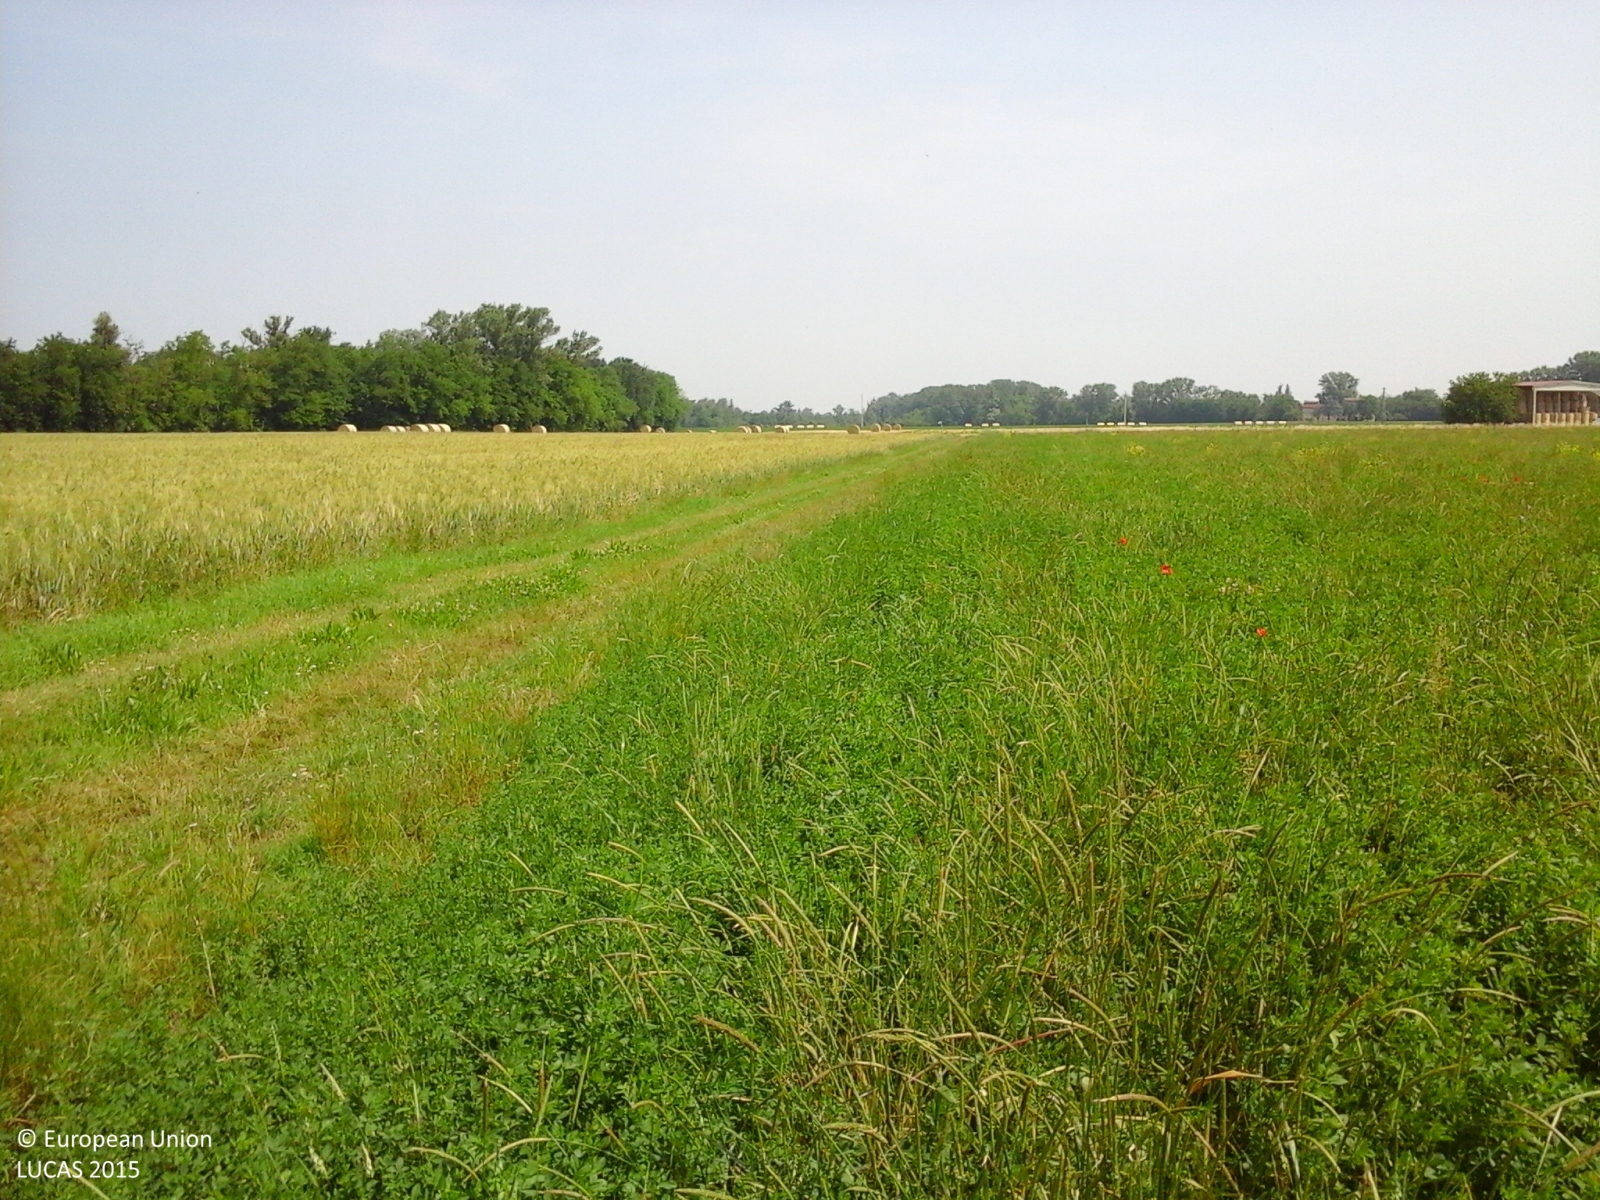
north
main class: Cropland
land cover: Lucerne
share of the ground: > 75 %
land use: Agriculture (excluding fallow land and kitchen gardens)
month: May
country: IT
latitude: 44.7651
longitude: 10.1891
